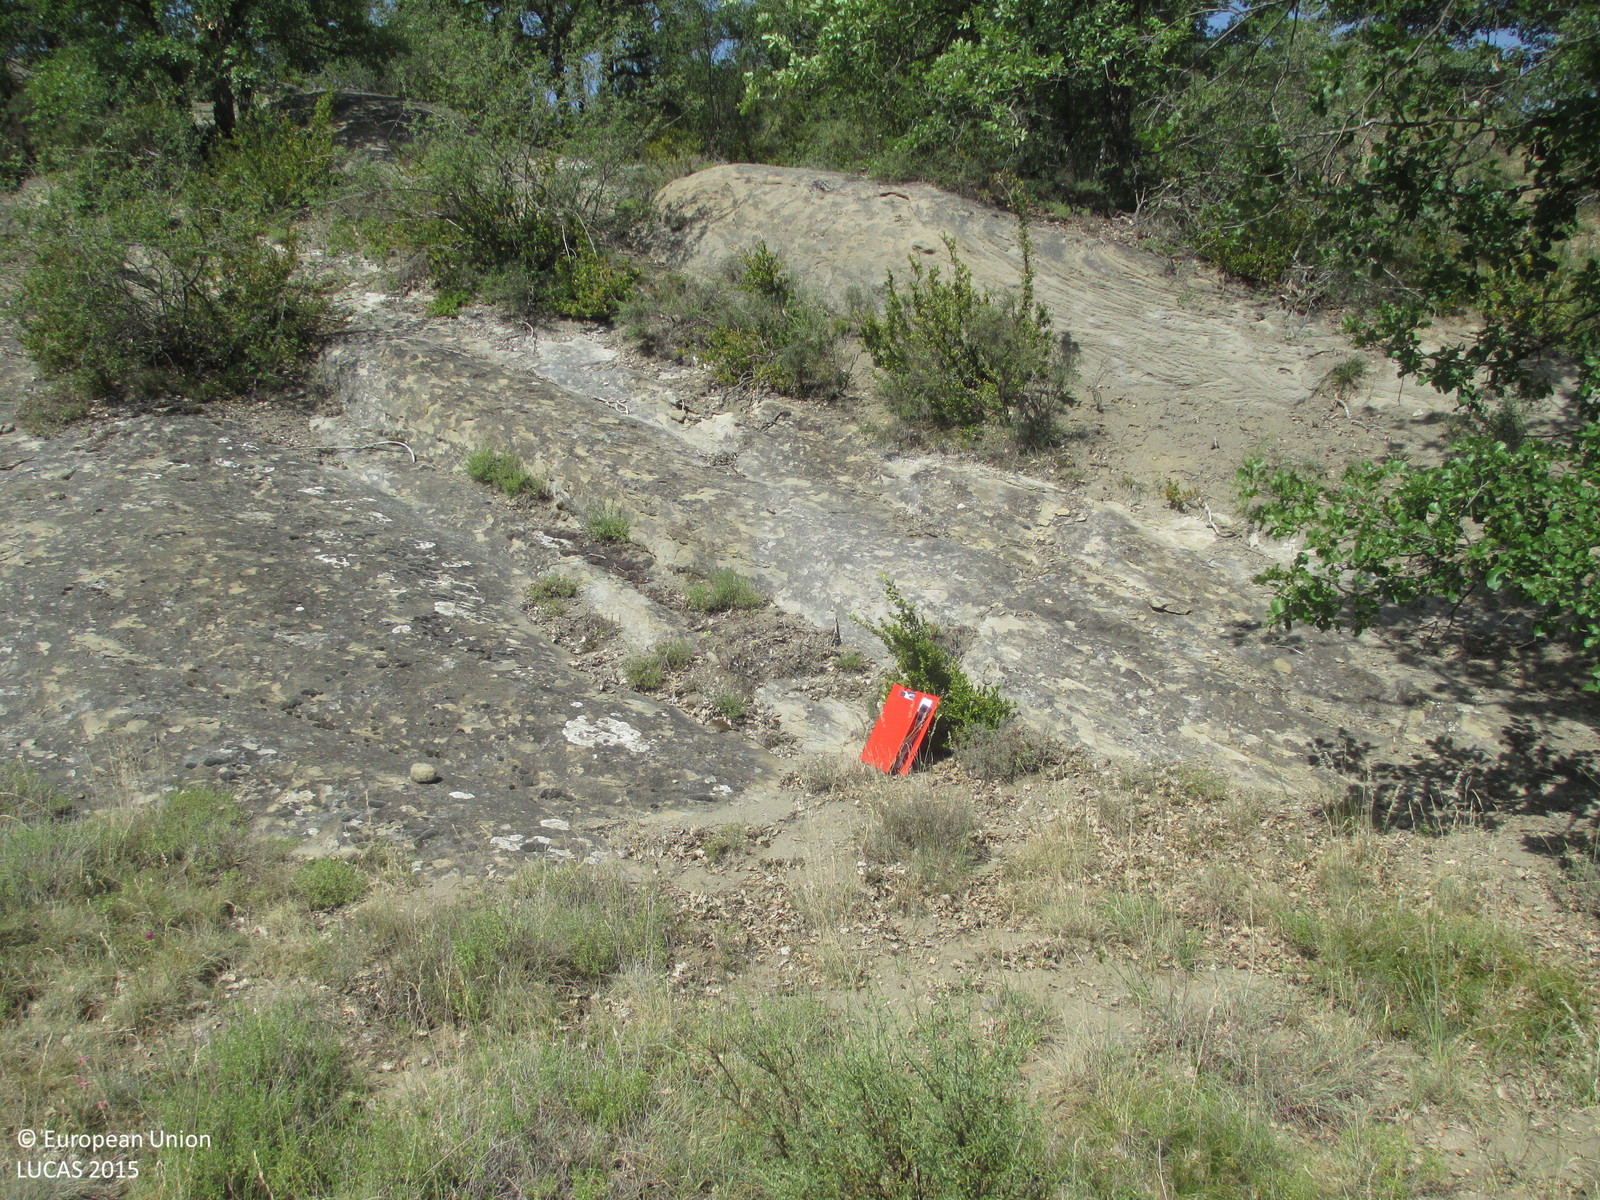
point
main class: Grassland
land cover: Grassland with sparse tree/shrub cover
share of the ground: > 75 %
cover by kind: herbaceous plants 85 %, coniferous forest trees 5 %, shrubs 5 %, consolidated bare surface 5 %
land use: Semi-natural and natural areas not in use
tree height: > 5 m
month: July
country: ES
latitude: 42.3712
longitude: -0.4073
